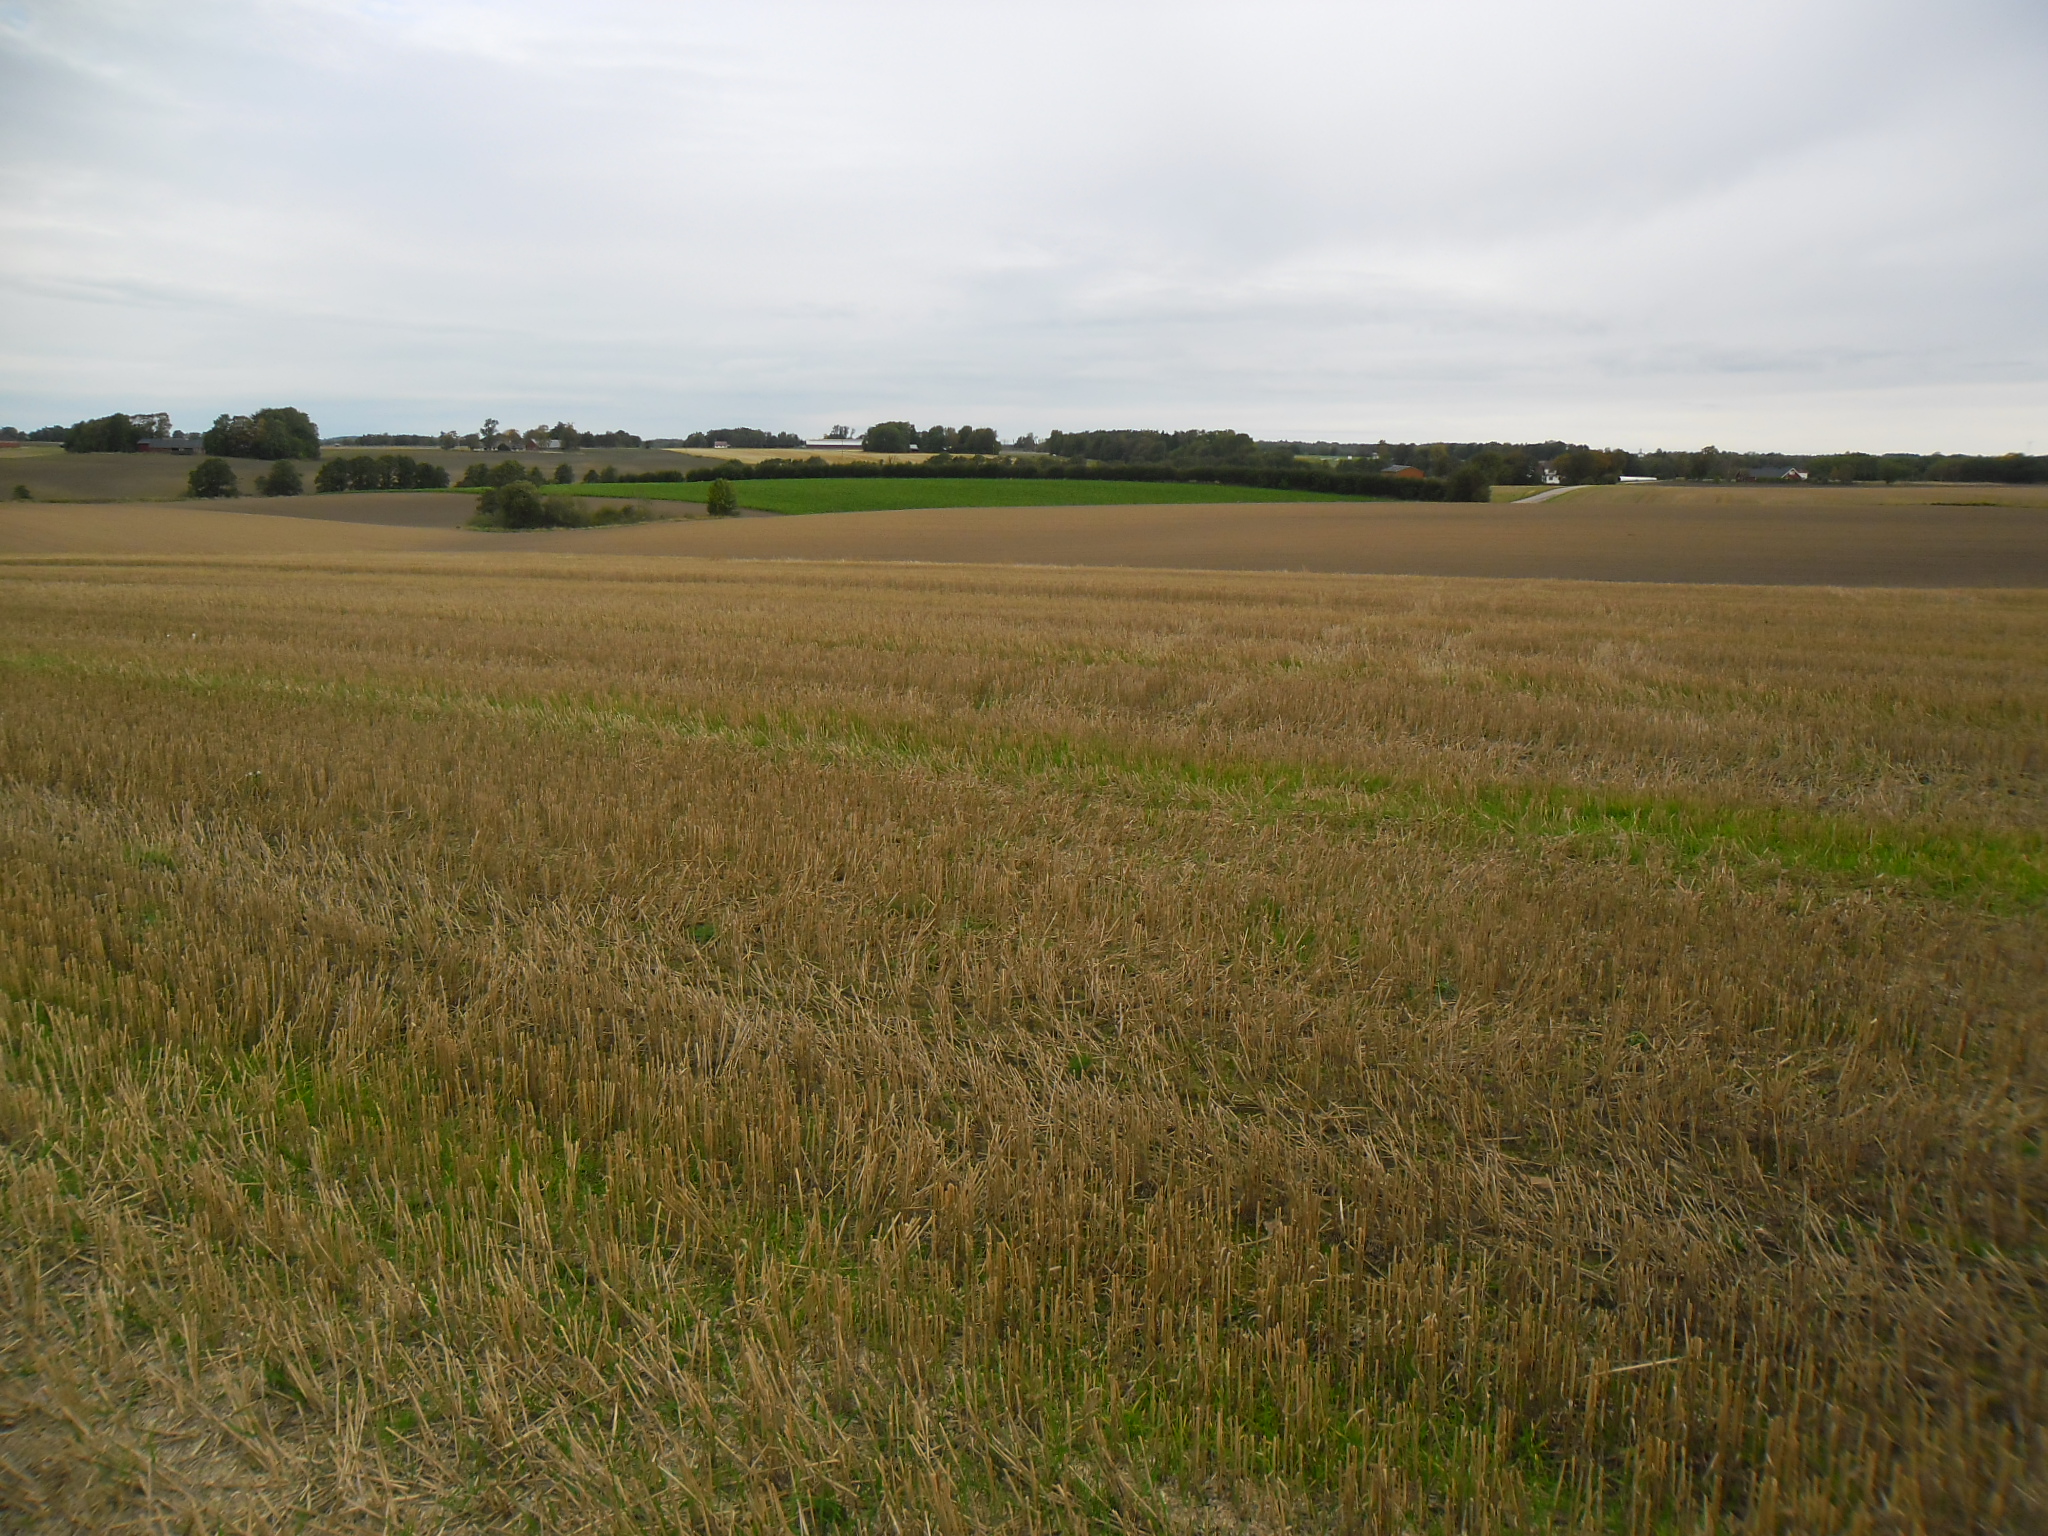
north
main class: Cropland
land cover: Common wheat
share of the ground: 10 - 25 %
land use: Agriculture (excluding fallow land and kitchen gardens)
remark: Harvested field
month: October
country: SE
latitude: 56.4743
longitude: 13.0978
